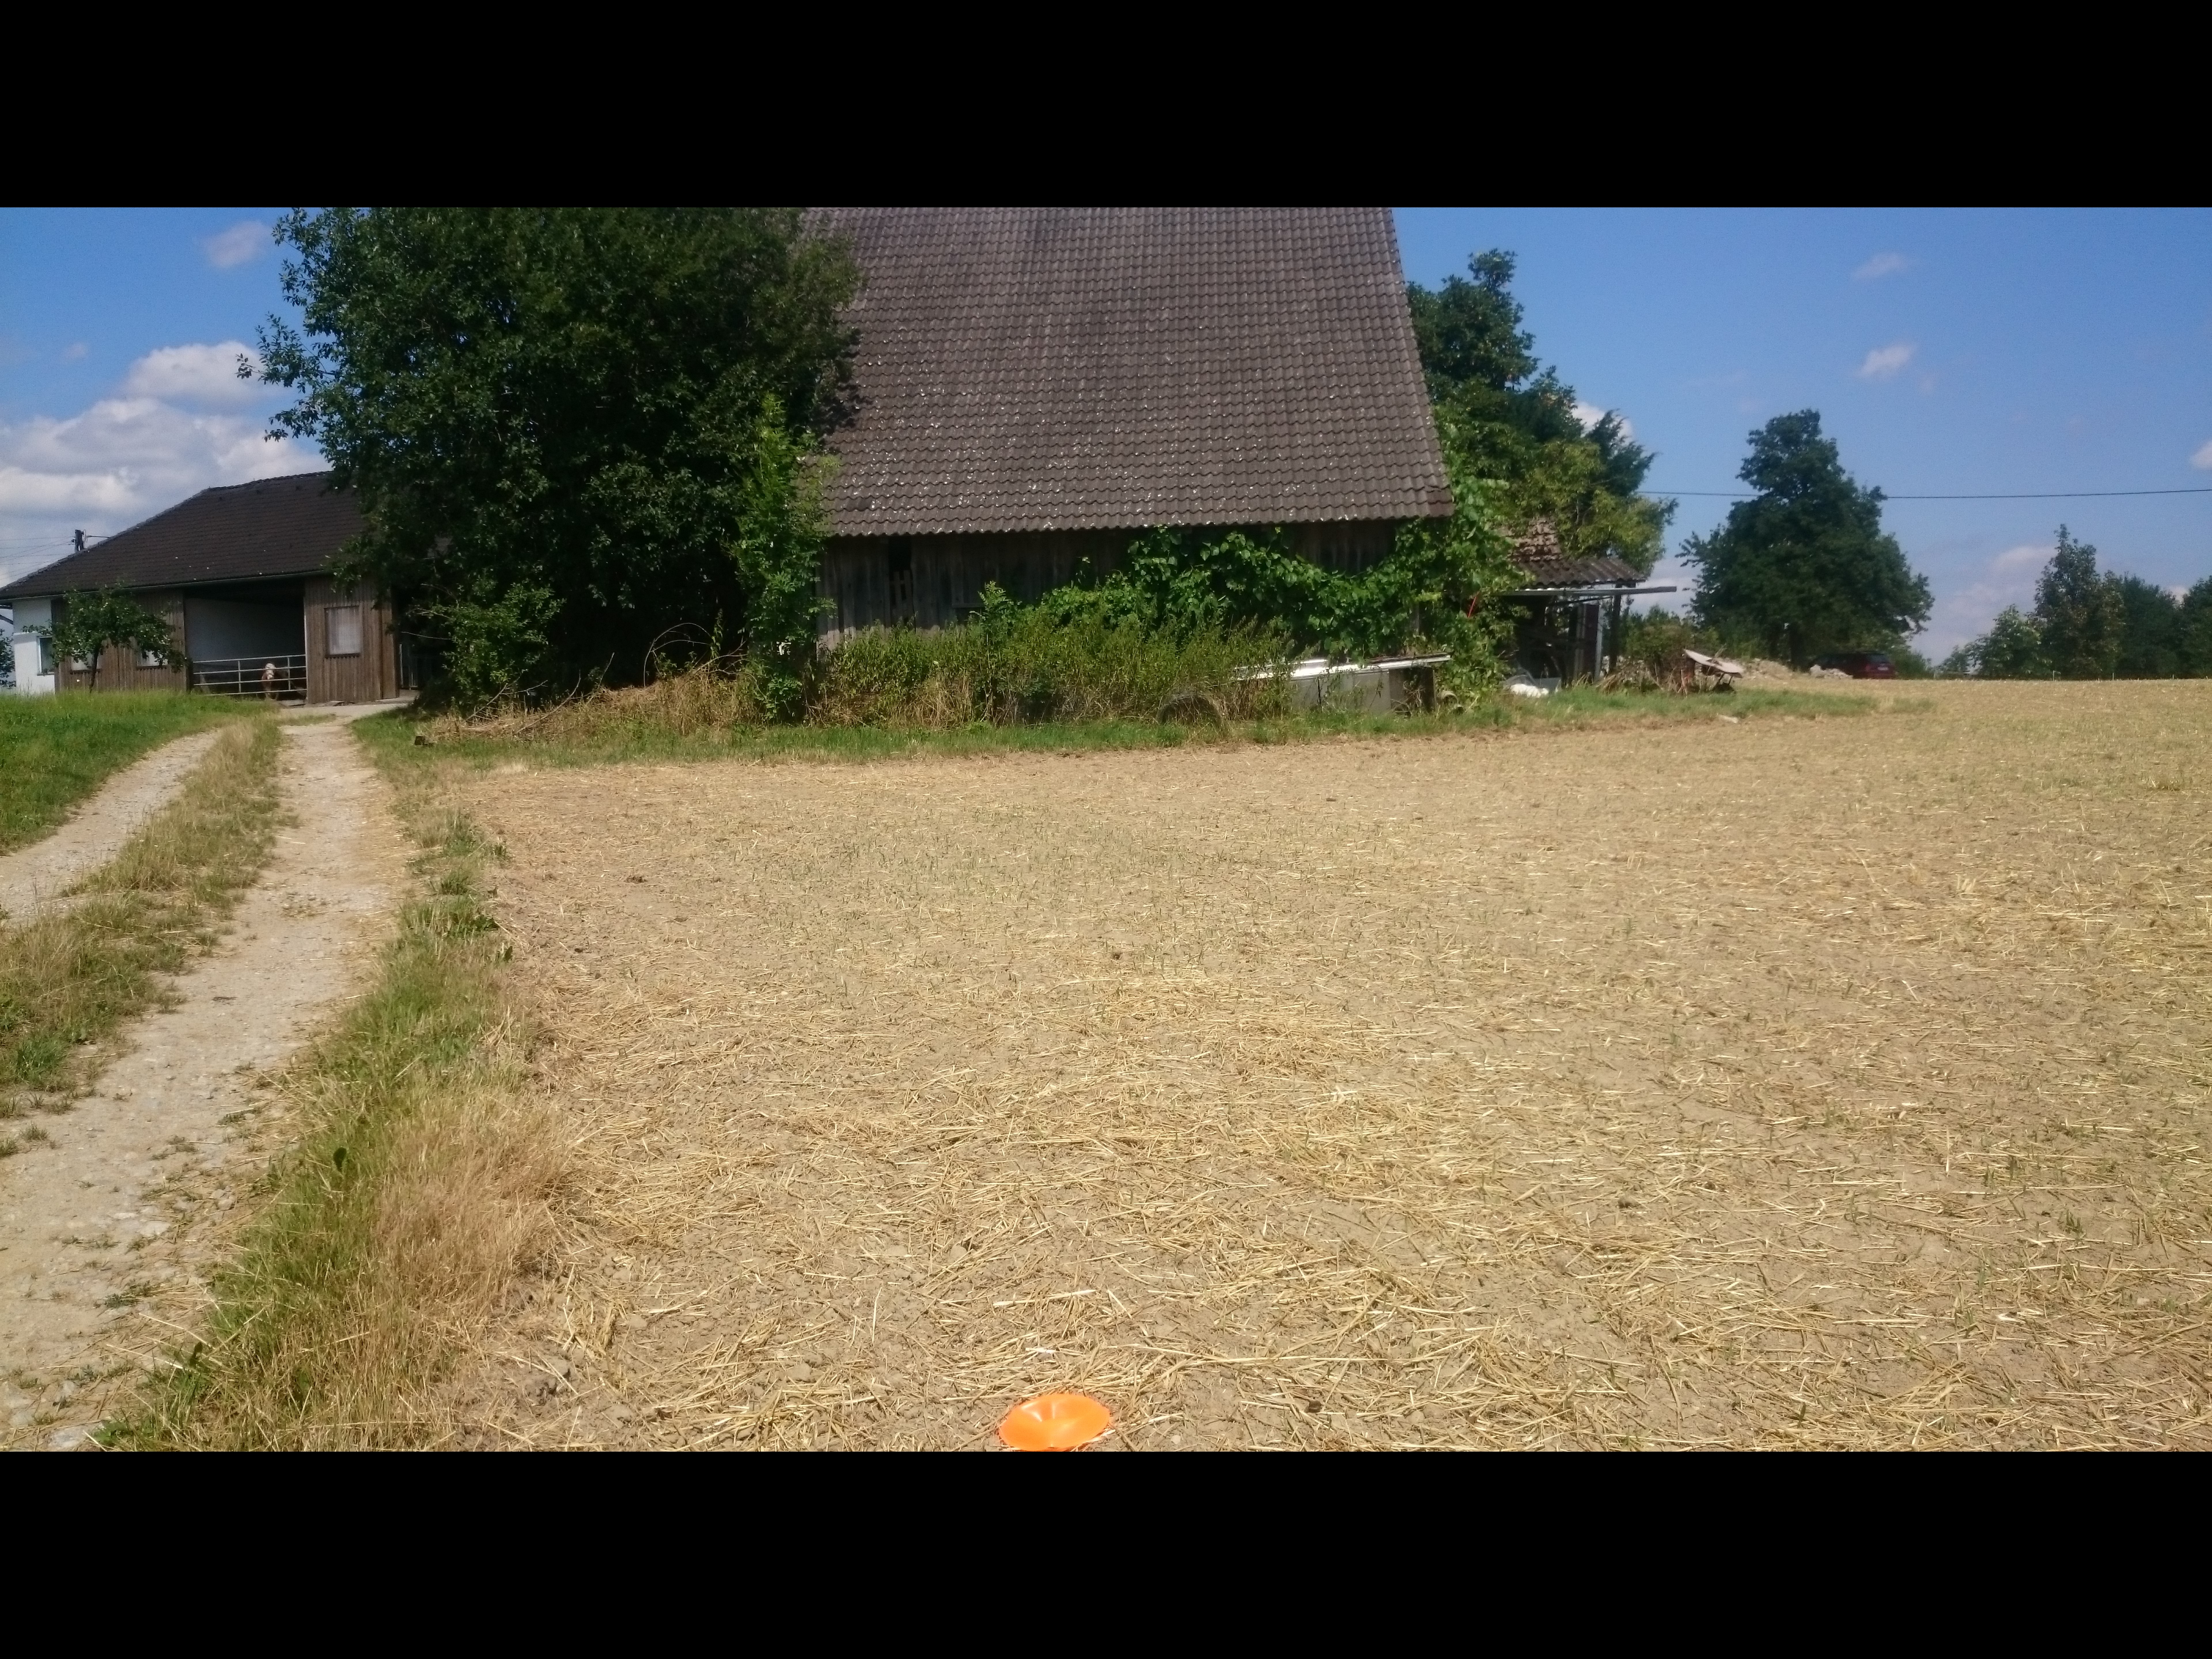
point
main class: Cropland
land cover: Barley
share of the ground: < 10 %
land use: Agriculture (excluding fallow land and kitchen gardens)
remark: Harvested field
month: July
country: AT
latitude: 48.2269
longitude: 14.8066
